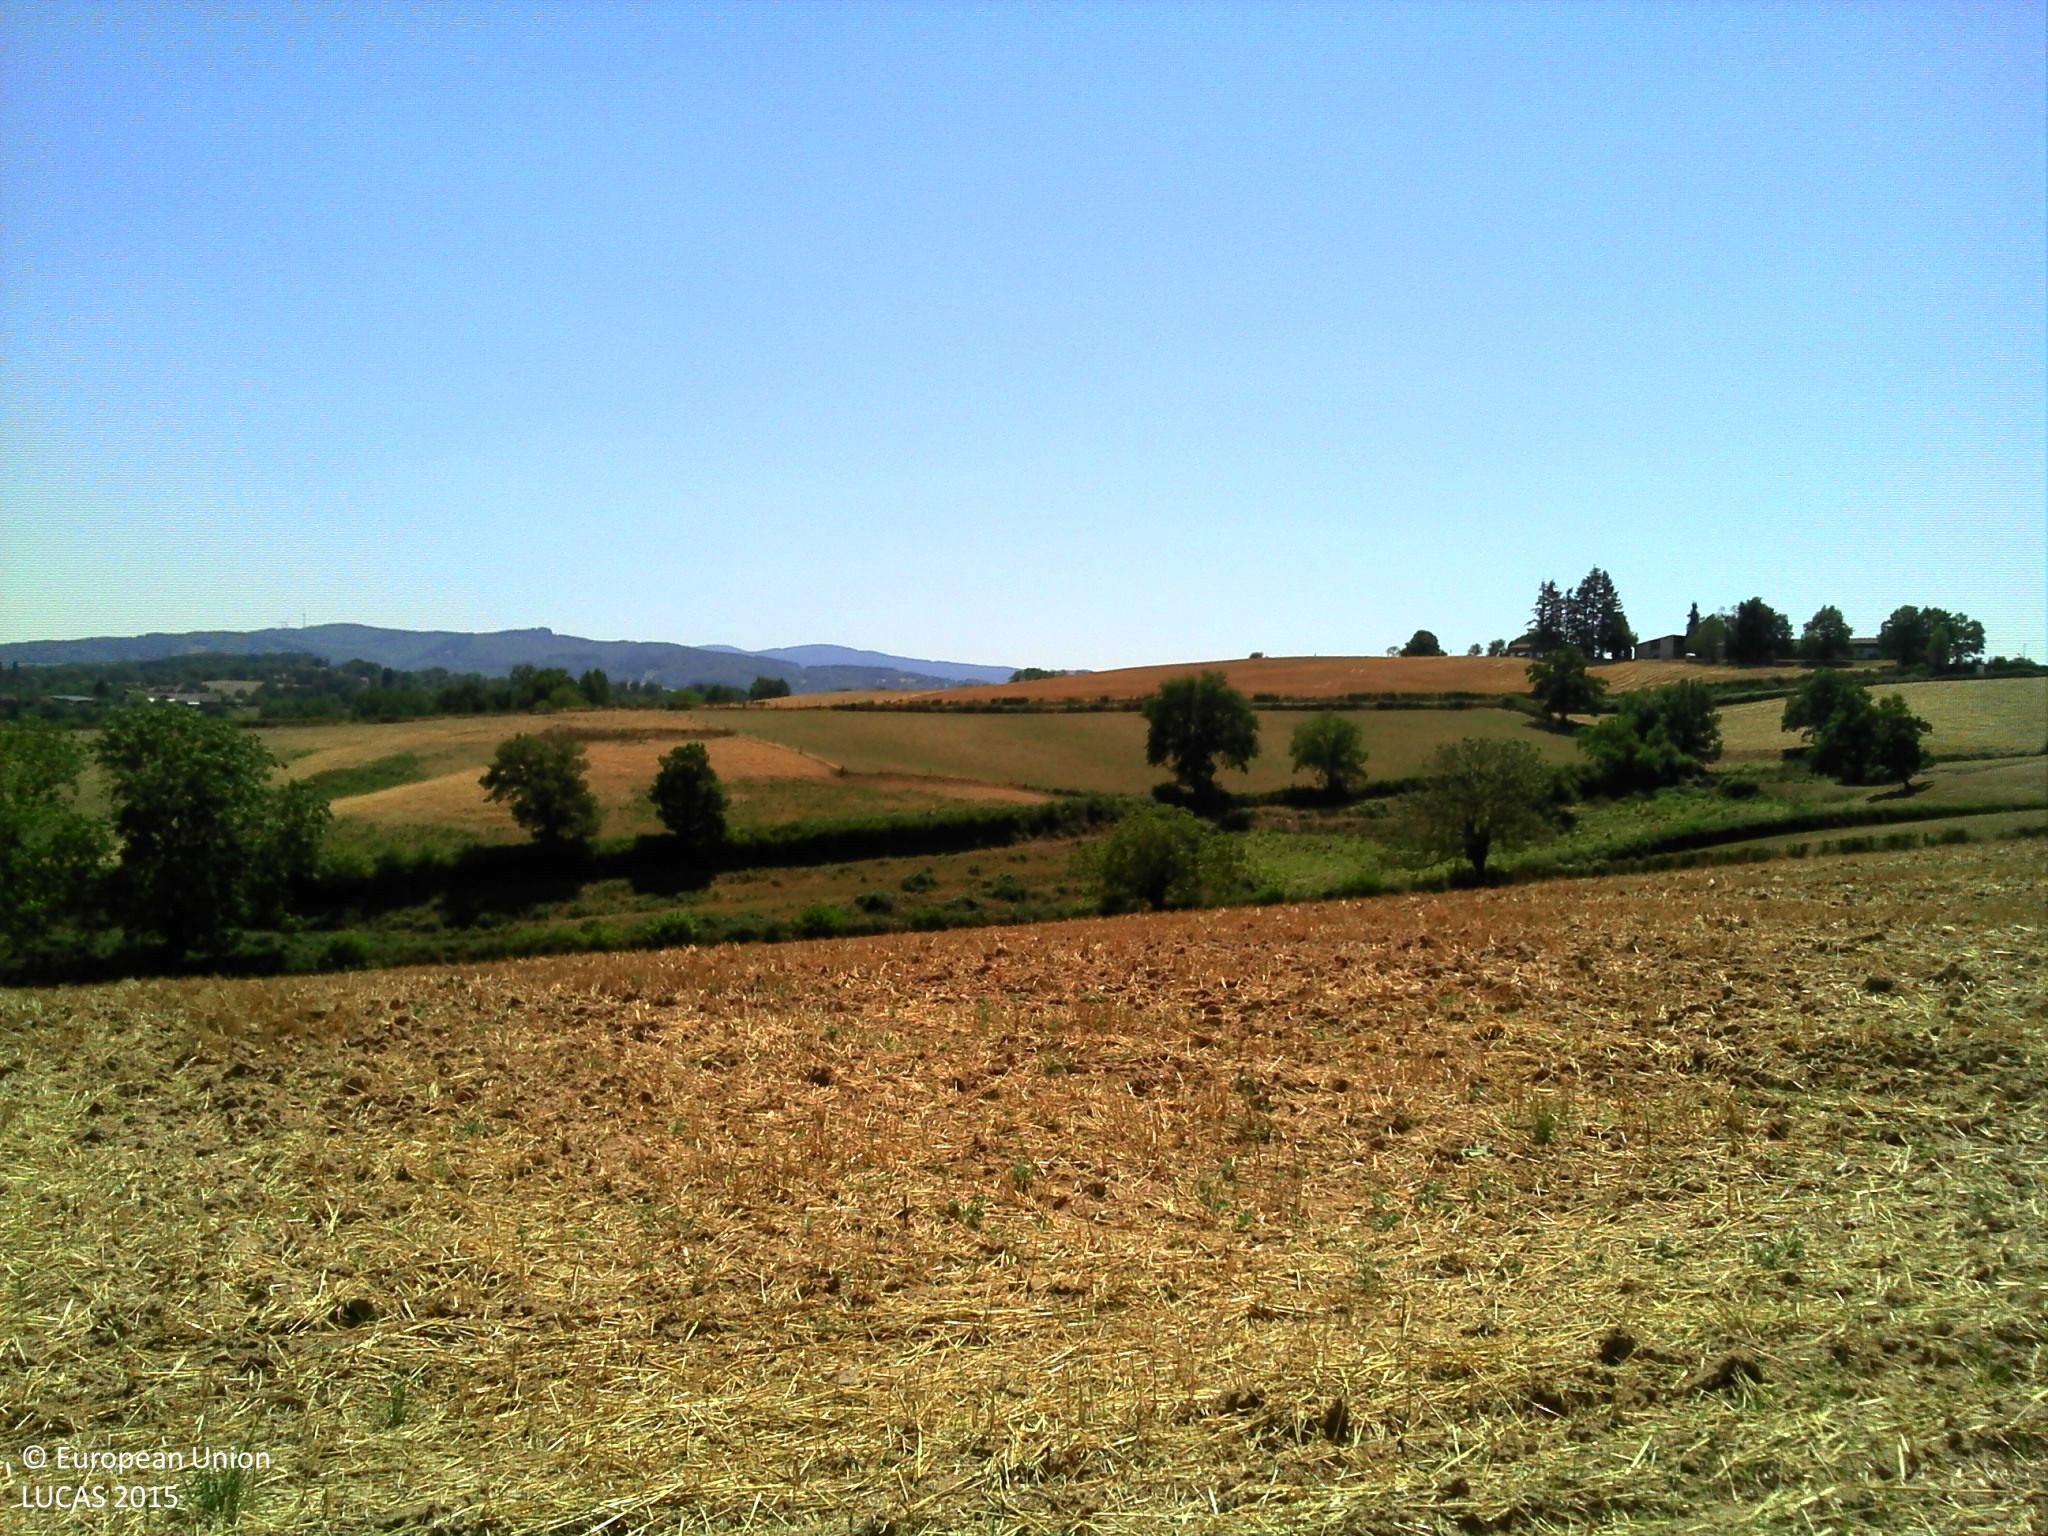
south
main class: Cropland
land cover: Triticale
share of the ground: 25 - 50 %
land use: Agriculture (excluding fallow land and kitchen gardens)
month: August
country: FR
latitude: 46.1082
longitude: 3.6480
